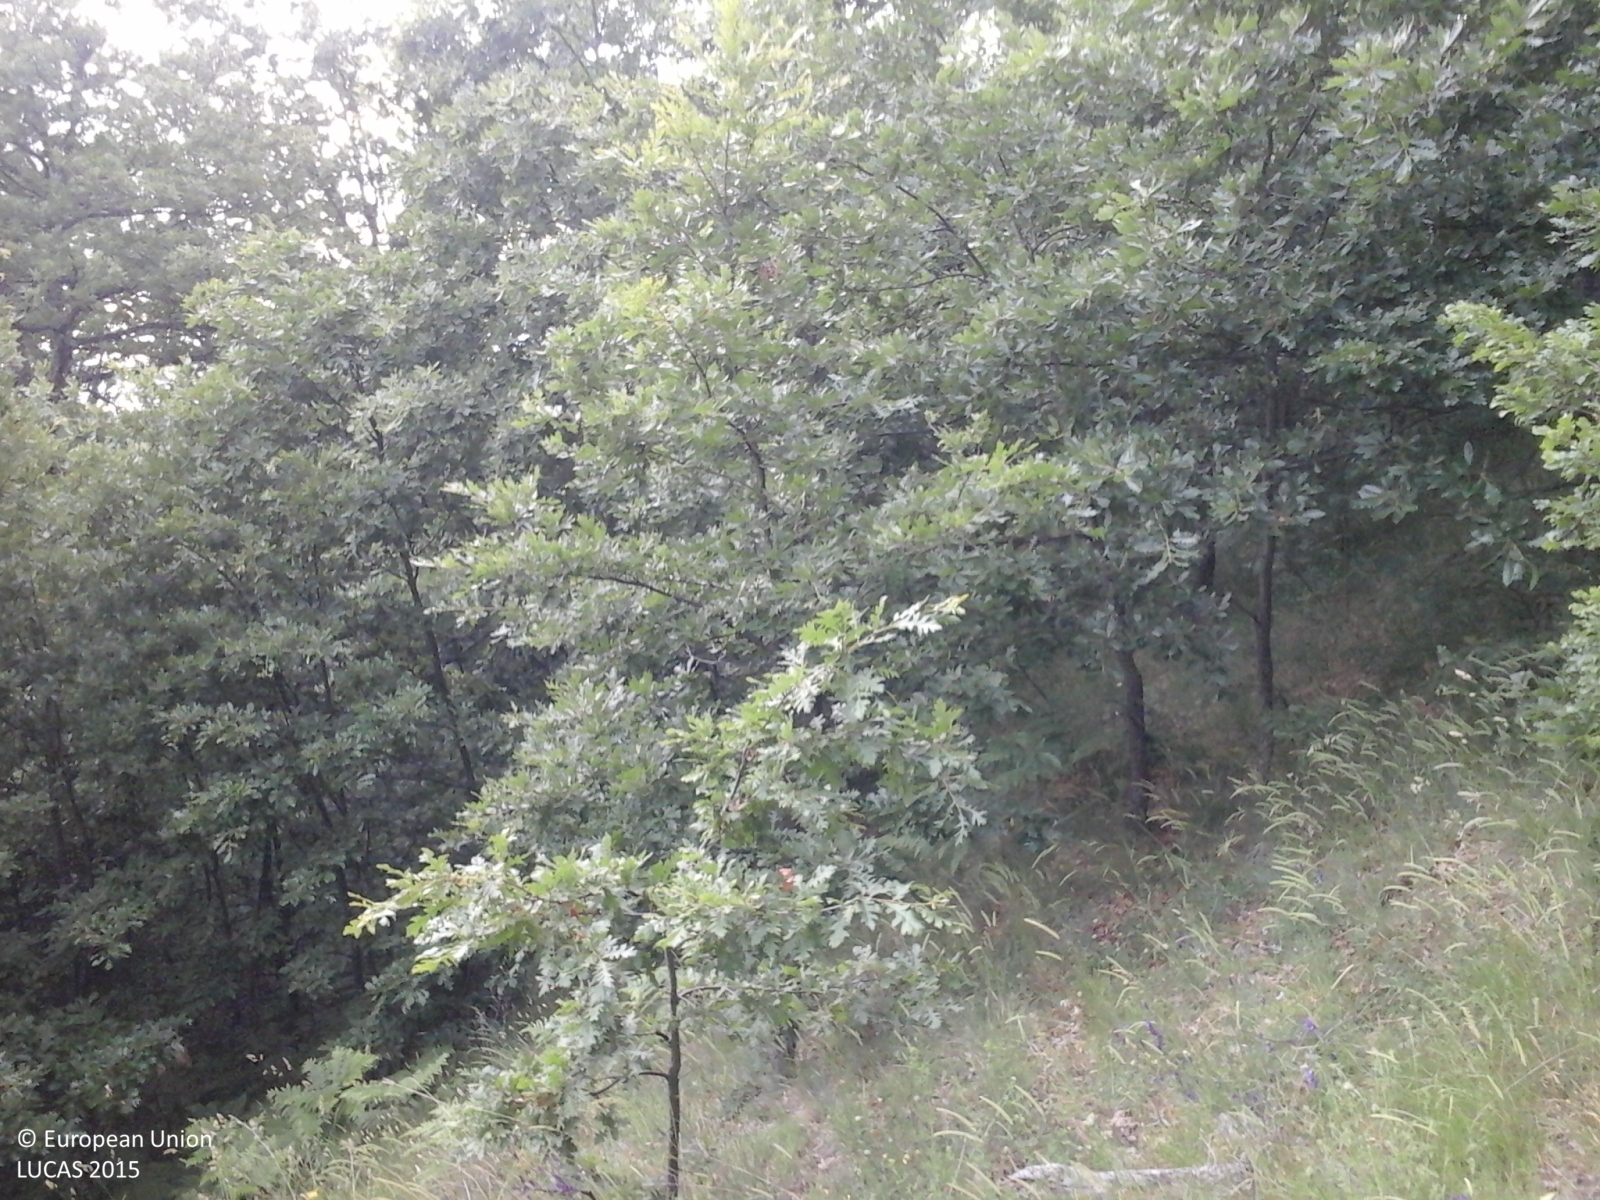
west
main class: Woodland
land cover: Broadleaved woodland
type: thermophilous deciduous forest
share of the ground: 50 - 75 %
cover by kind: broadleaved forest trees 50 %, herbaceous plants 50 %
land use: Forestry
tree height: > 5 m
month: June
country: GR
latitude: 40.6074
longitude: 21.3731
